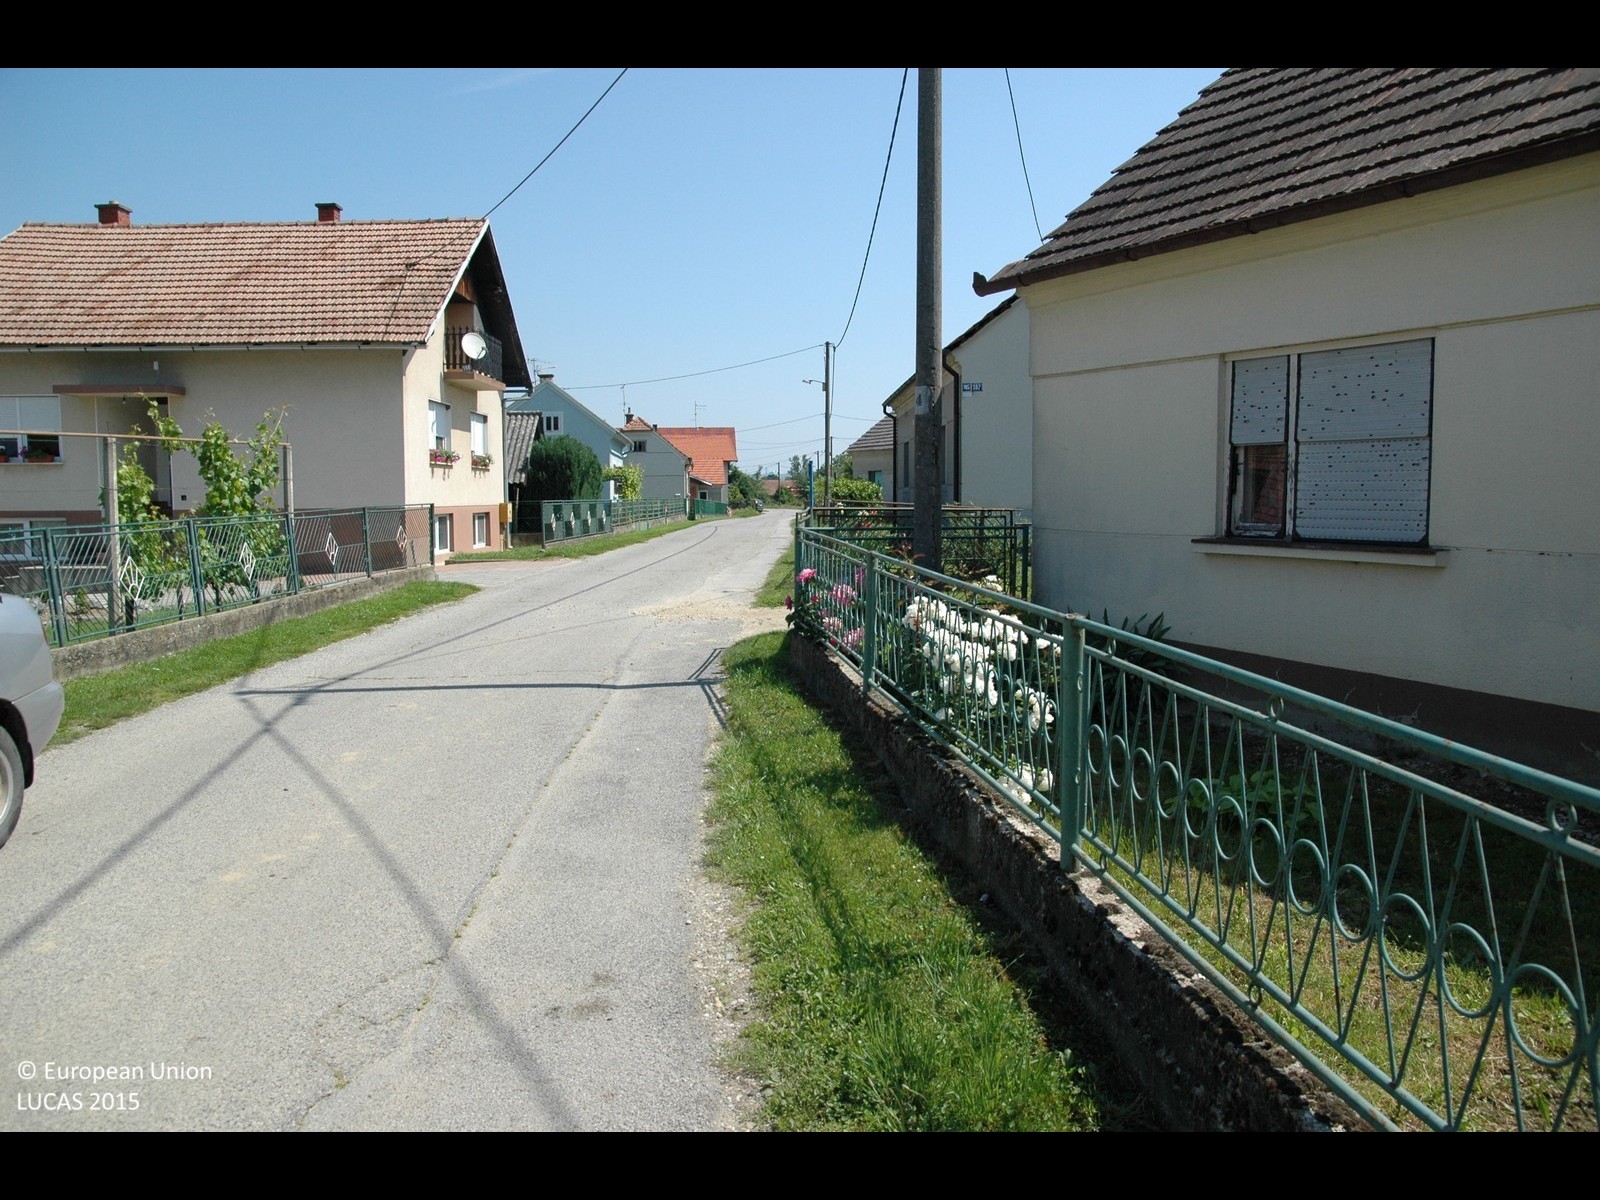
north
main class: Grassland
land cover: Grassland without tree/shrub cover
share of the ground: > 75 %
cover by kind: herbaceous plants 100 %
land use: Residential
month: May
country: HR
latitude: 46.5207
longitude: 16.4012
